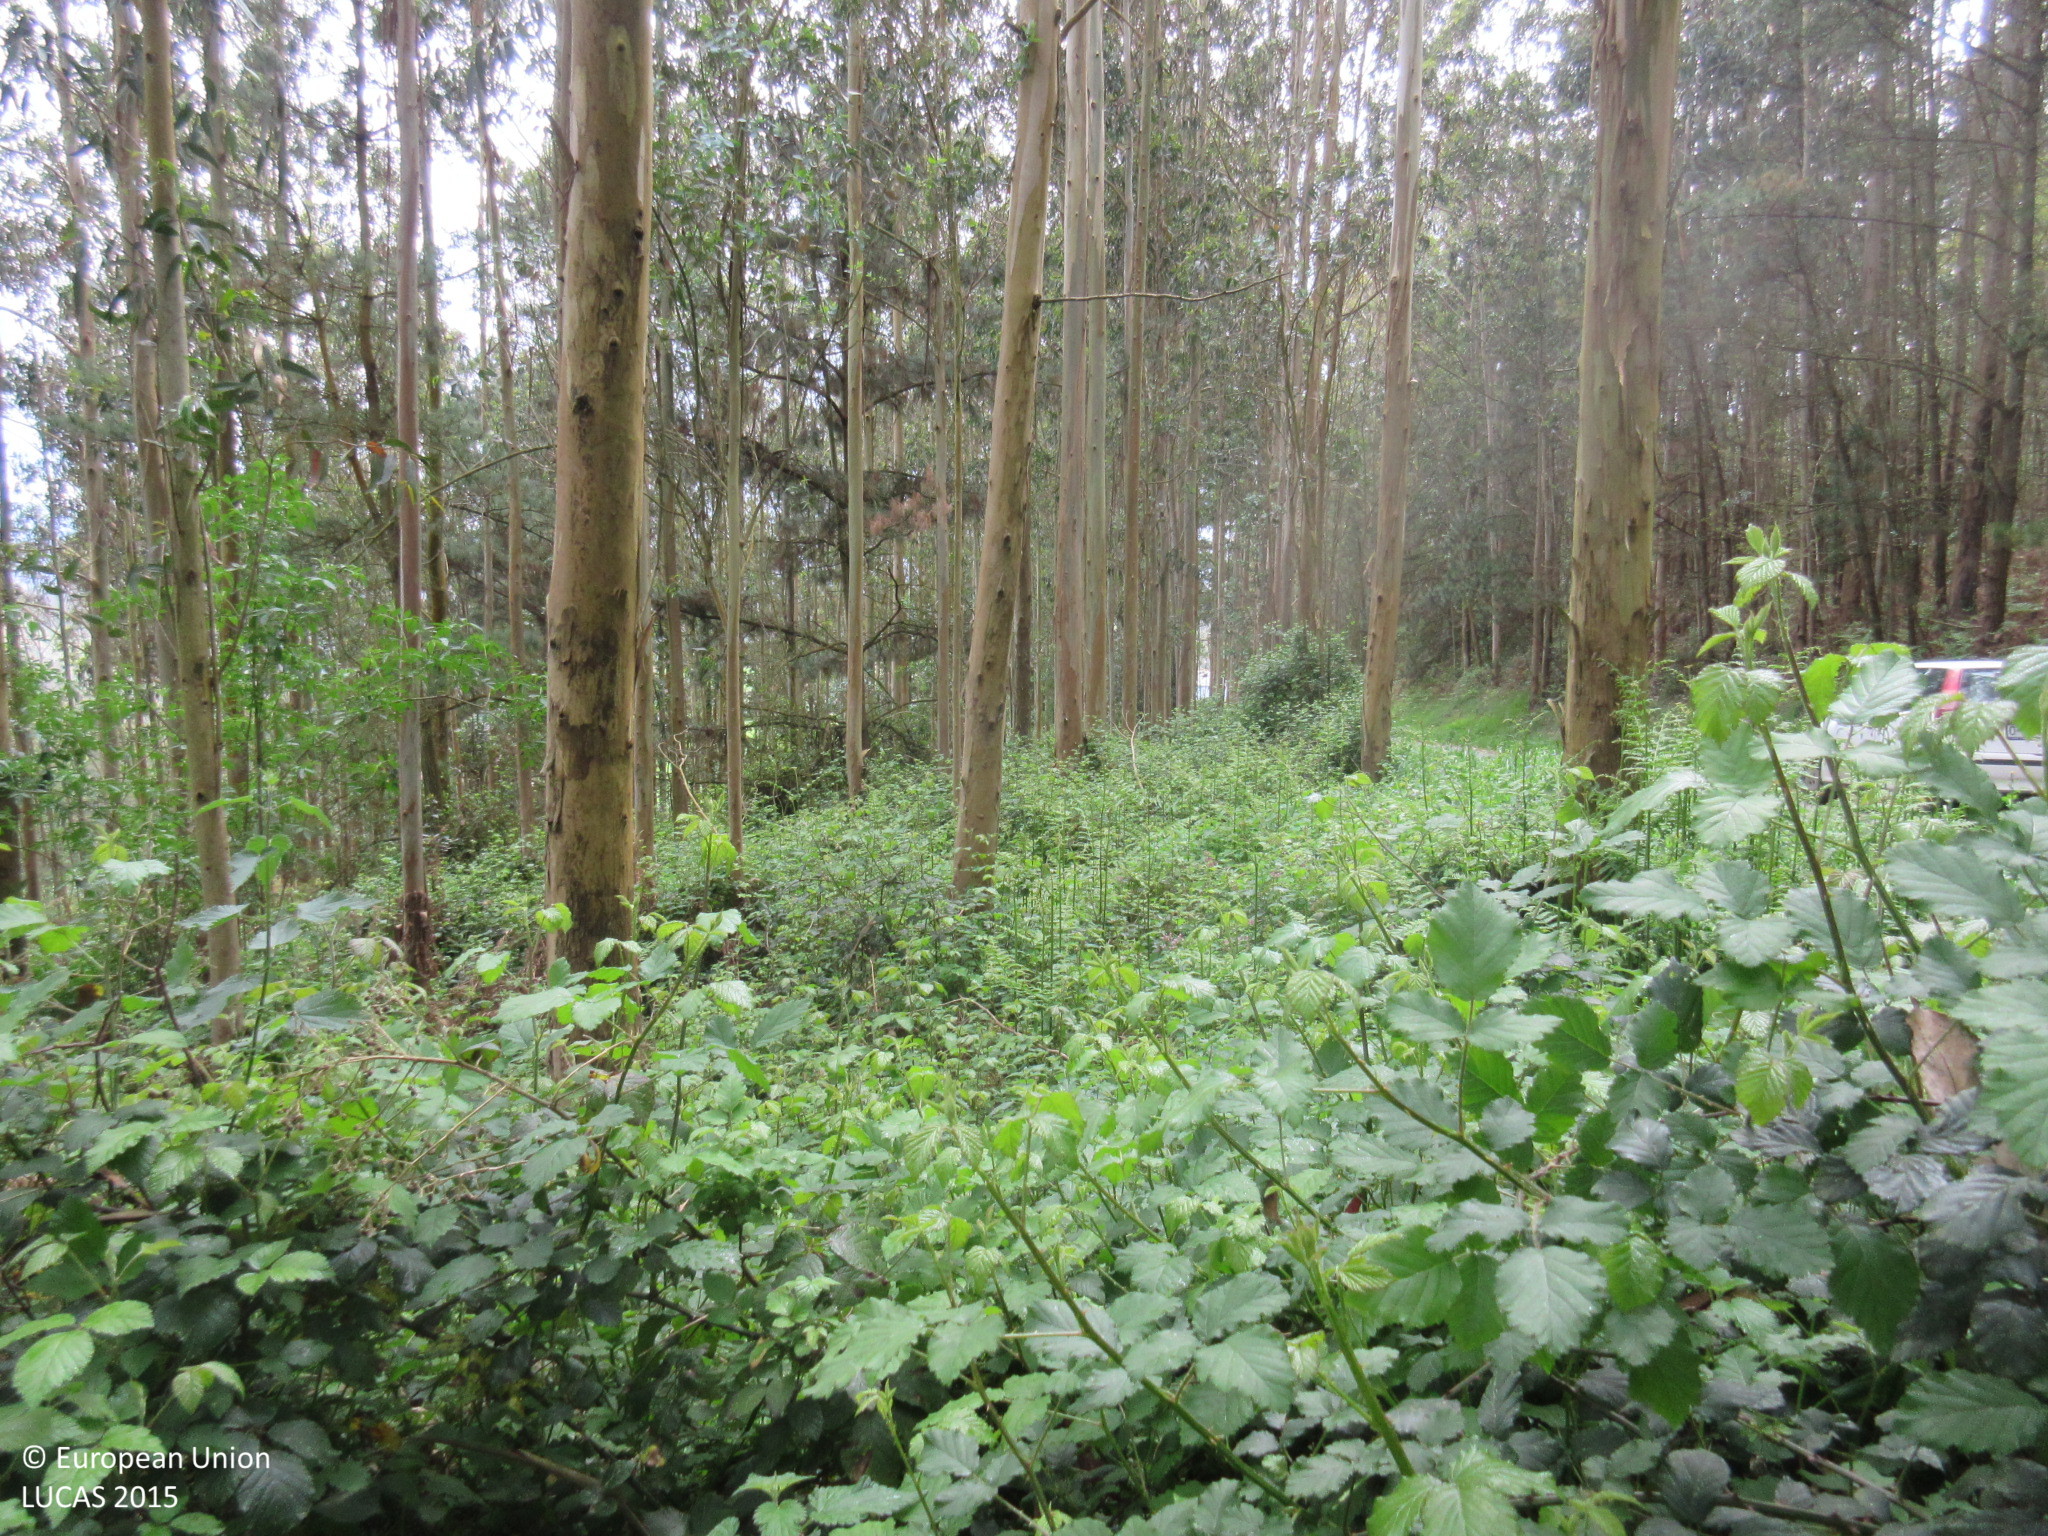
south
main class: Woodland
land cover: Broadleaved woodland
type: exotic forest
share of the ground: > 75 %
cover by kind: broadleaved forest trees 95 %, shrubs 5 %
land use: Forestry
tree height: > 5 m
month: April
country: ES
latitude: 43.4770
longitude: -7.1699
